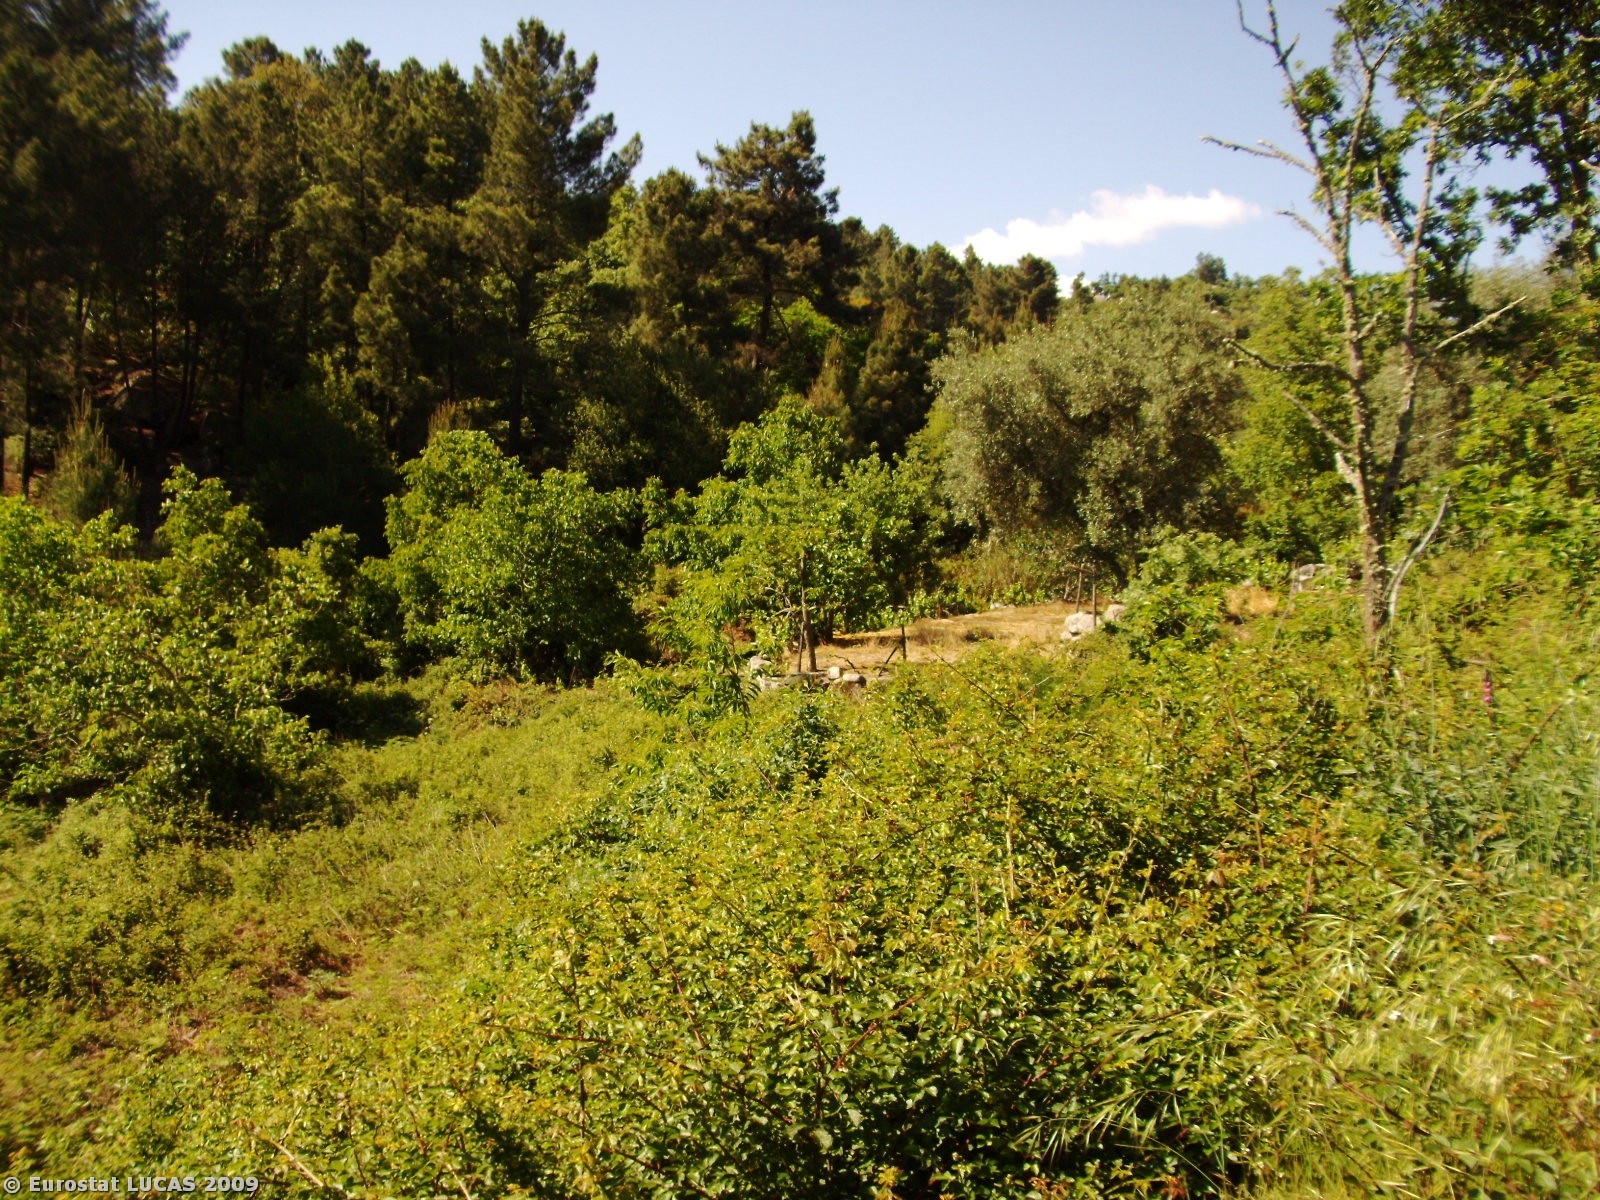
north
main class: Woodland
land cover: Coniferous woodland
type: coniferous forest of the mediterranean region
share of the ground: 25 - 50 %
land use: Forestry
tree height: > 5 m
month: May
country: PT
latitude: 41.0961
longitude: -7.6134
